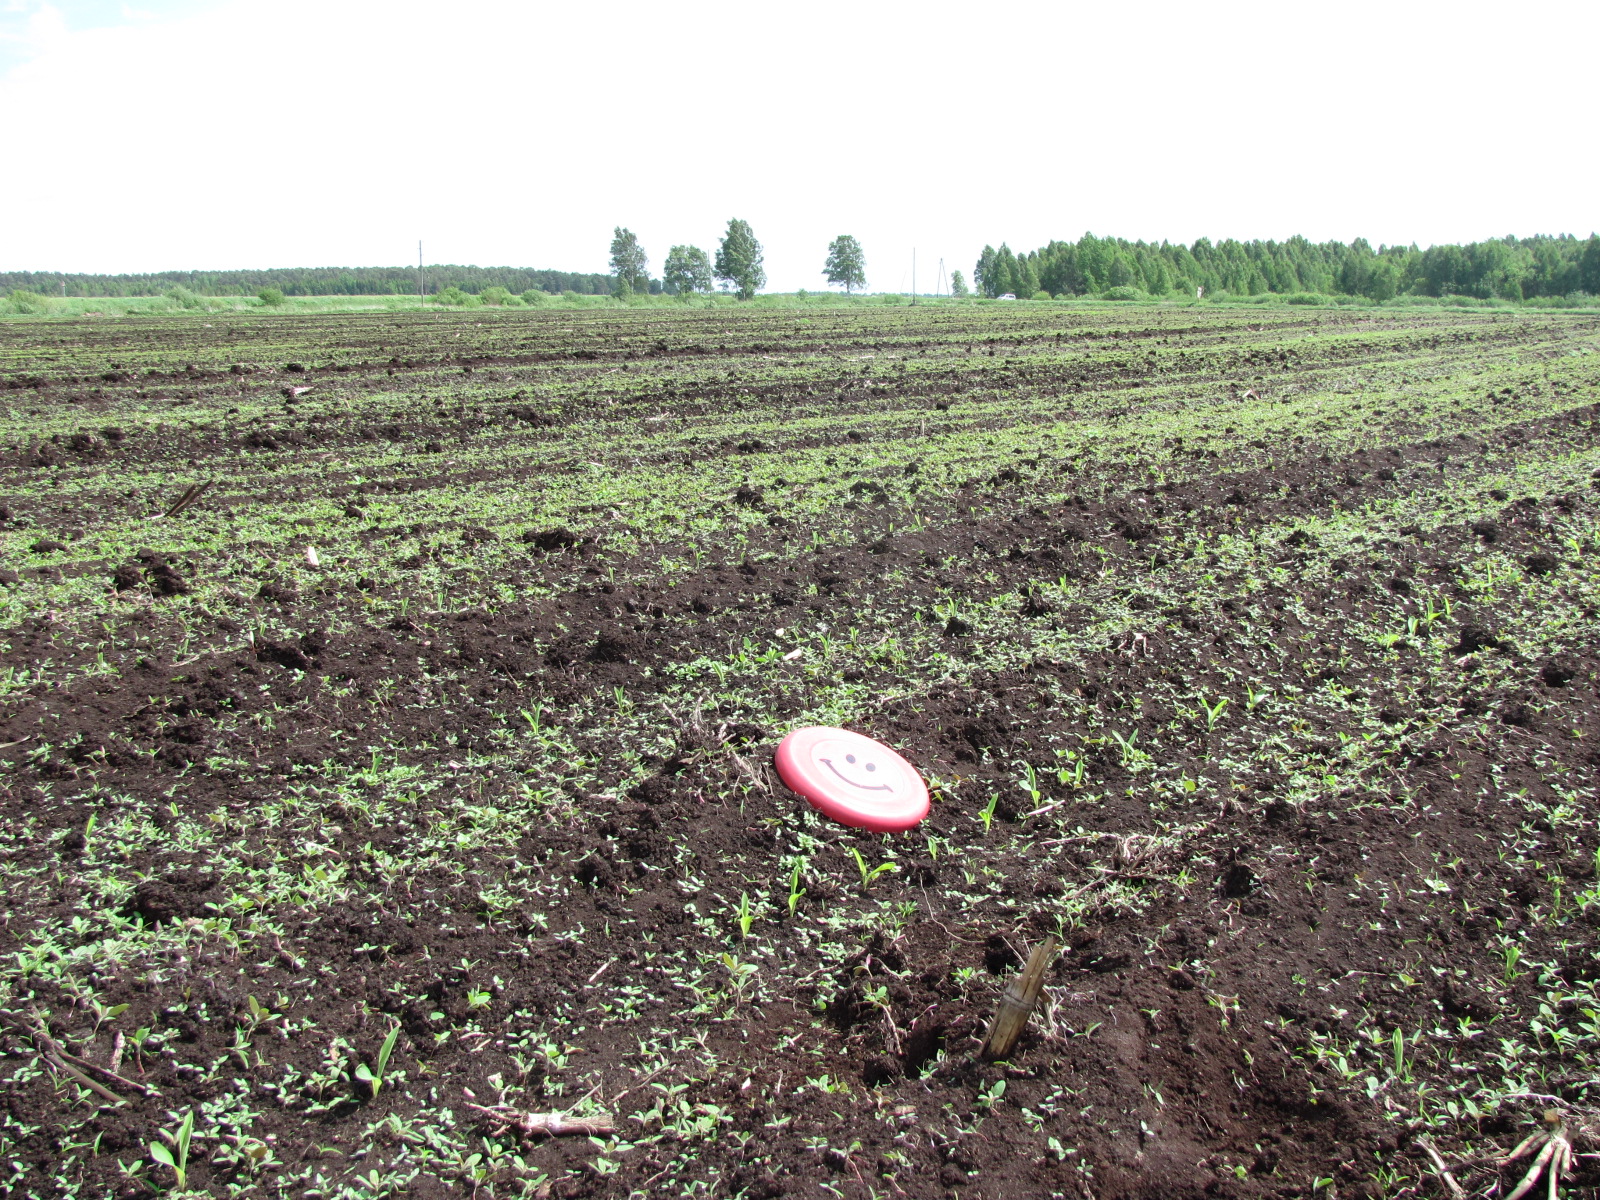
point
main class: Cropland
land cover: Maize
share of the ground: < 10 %
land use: Agriculture (excluding fallow land and kitchen gardens)
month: June
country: LV
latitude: 56.8622
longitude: 23.9755
